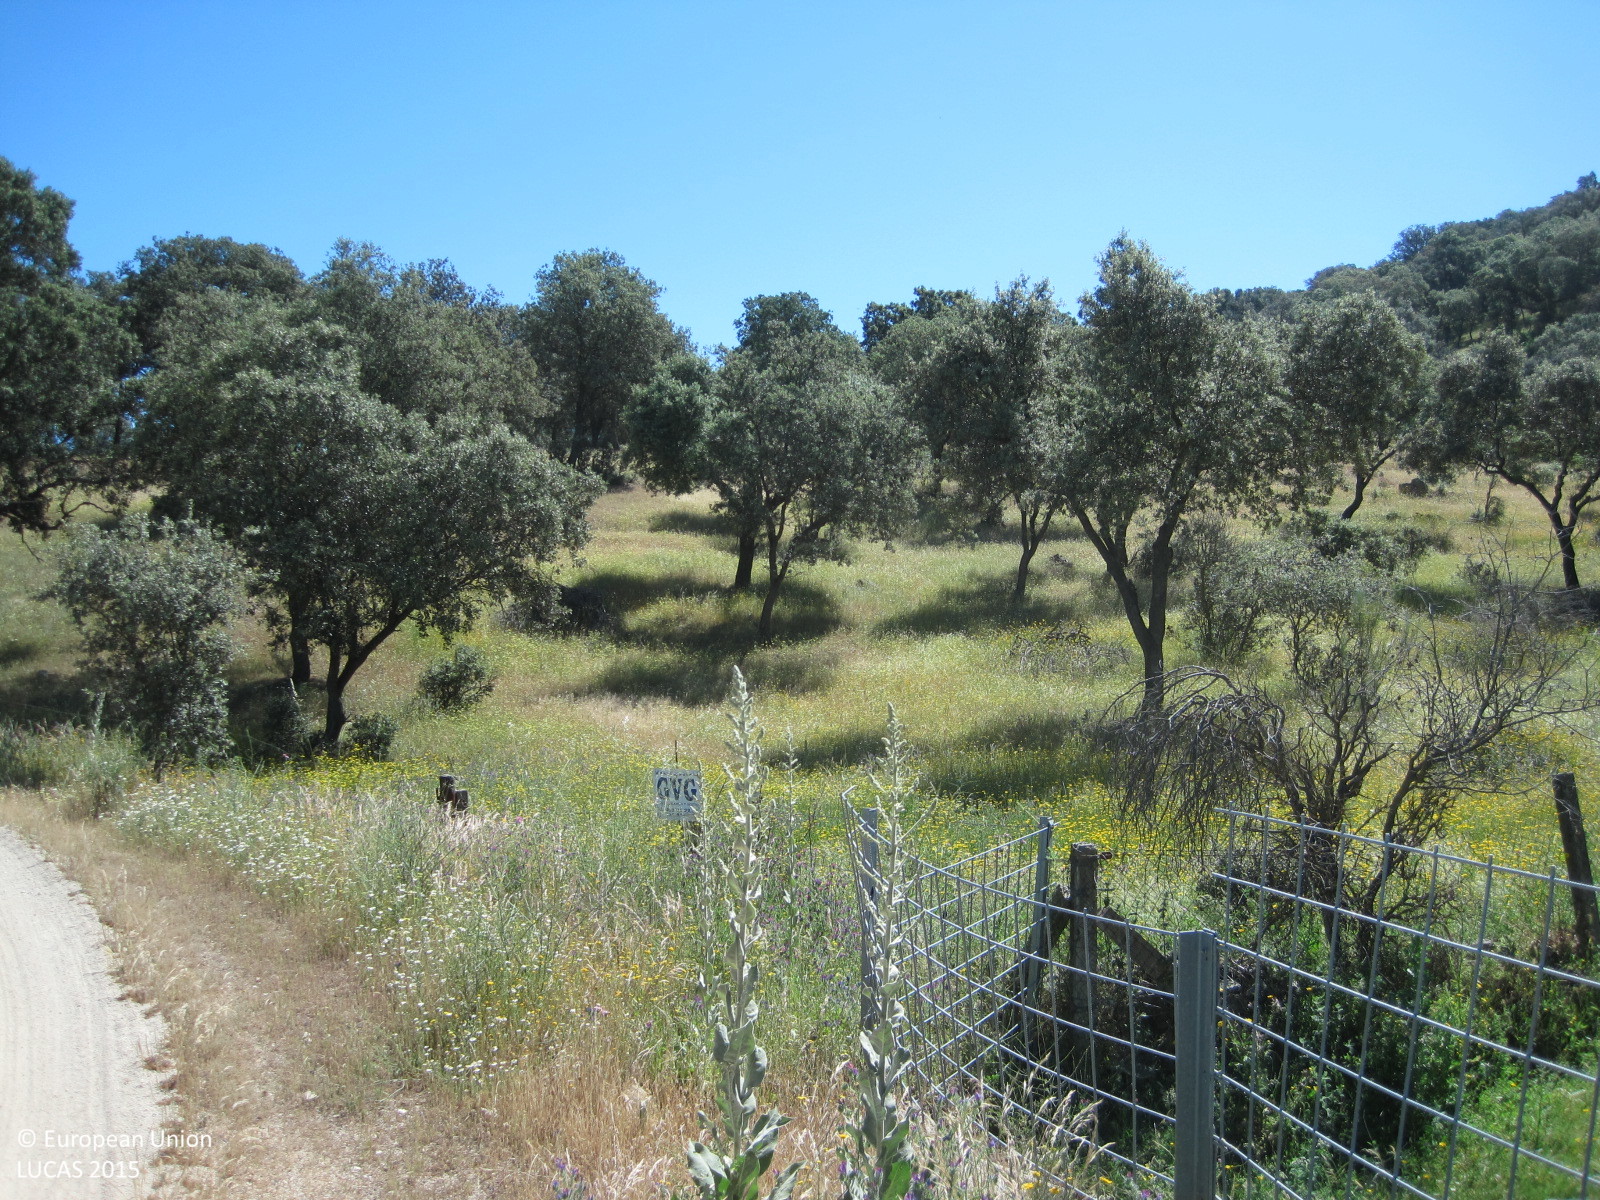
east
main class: Woodland
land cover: Broadleaved woodland
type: broadleaved evergreen forest
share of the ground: 50 - 75 %
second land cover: Grassland without tree/shrub cover
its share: > 75 %
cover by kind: broadleaved forest trees 70 %, herbaceous plants 30 %
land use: Forestry
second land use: Agriculture (excluding fallow land and kitchen gardens)
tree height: > 5 m
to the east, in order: Broadleaved woodland; Grassland without tree/shrub cover
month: May
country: ES
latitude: 40.1999
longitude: -4.8178
